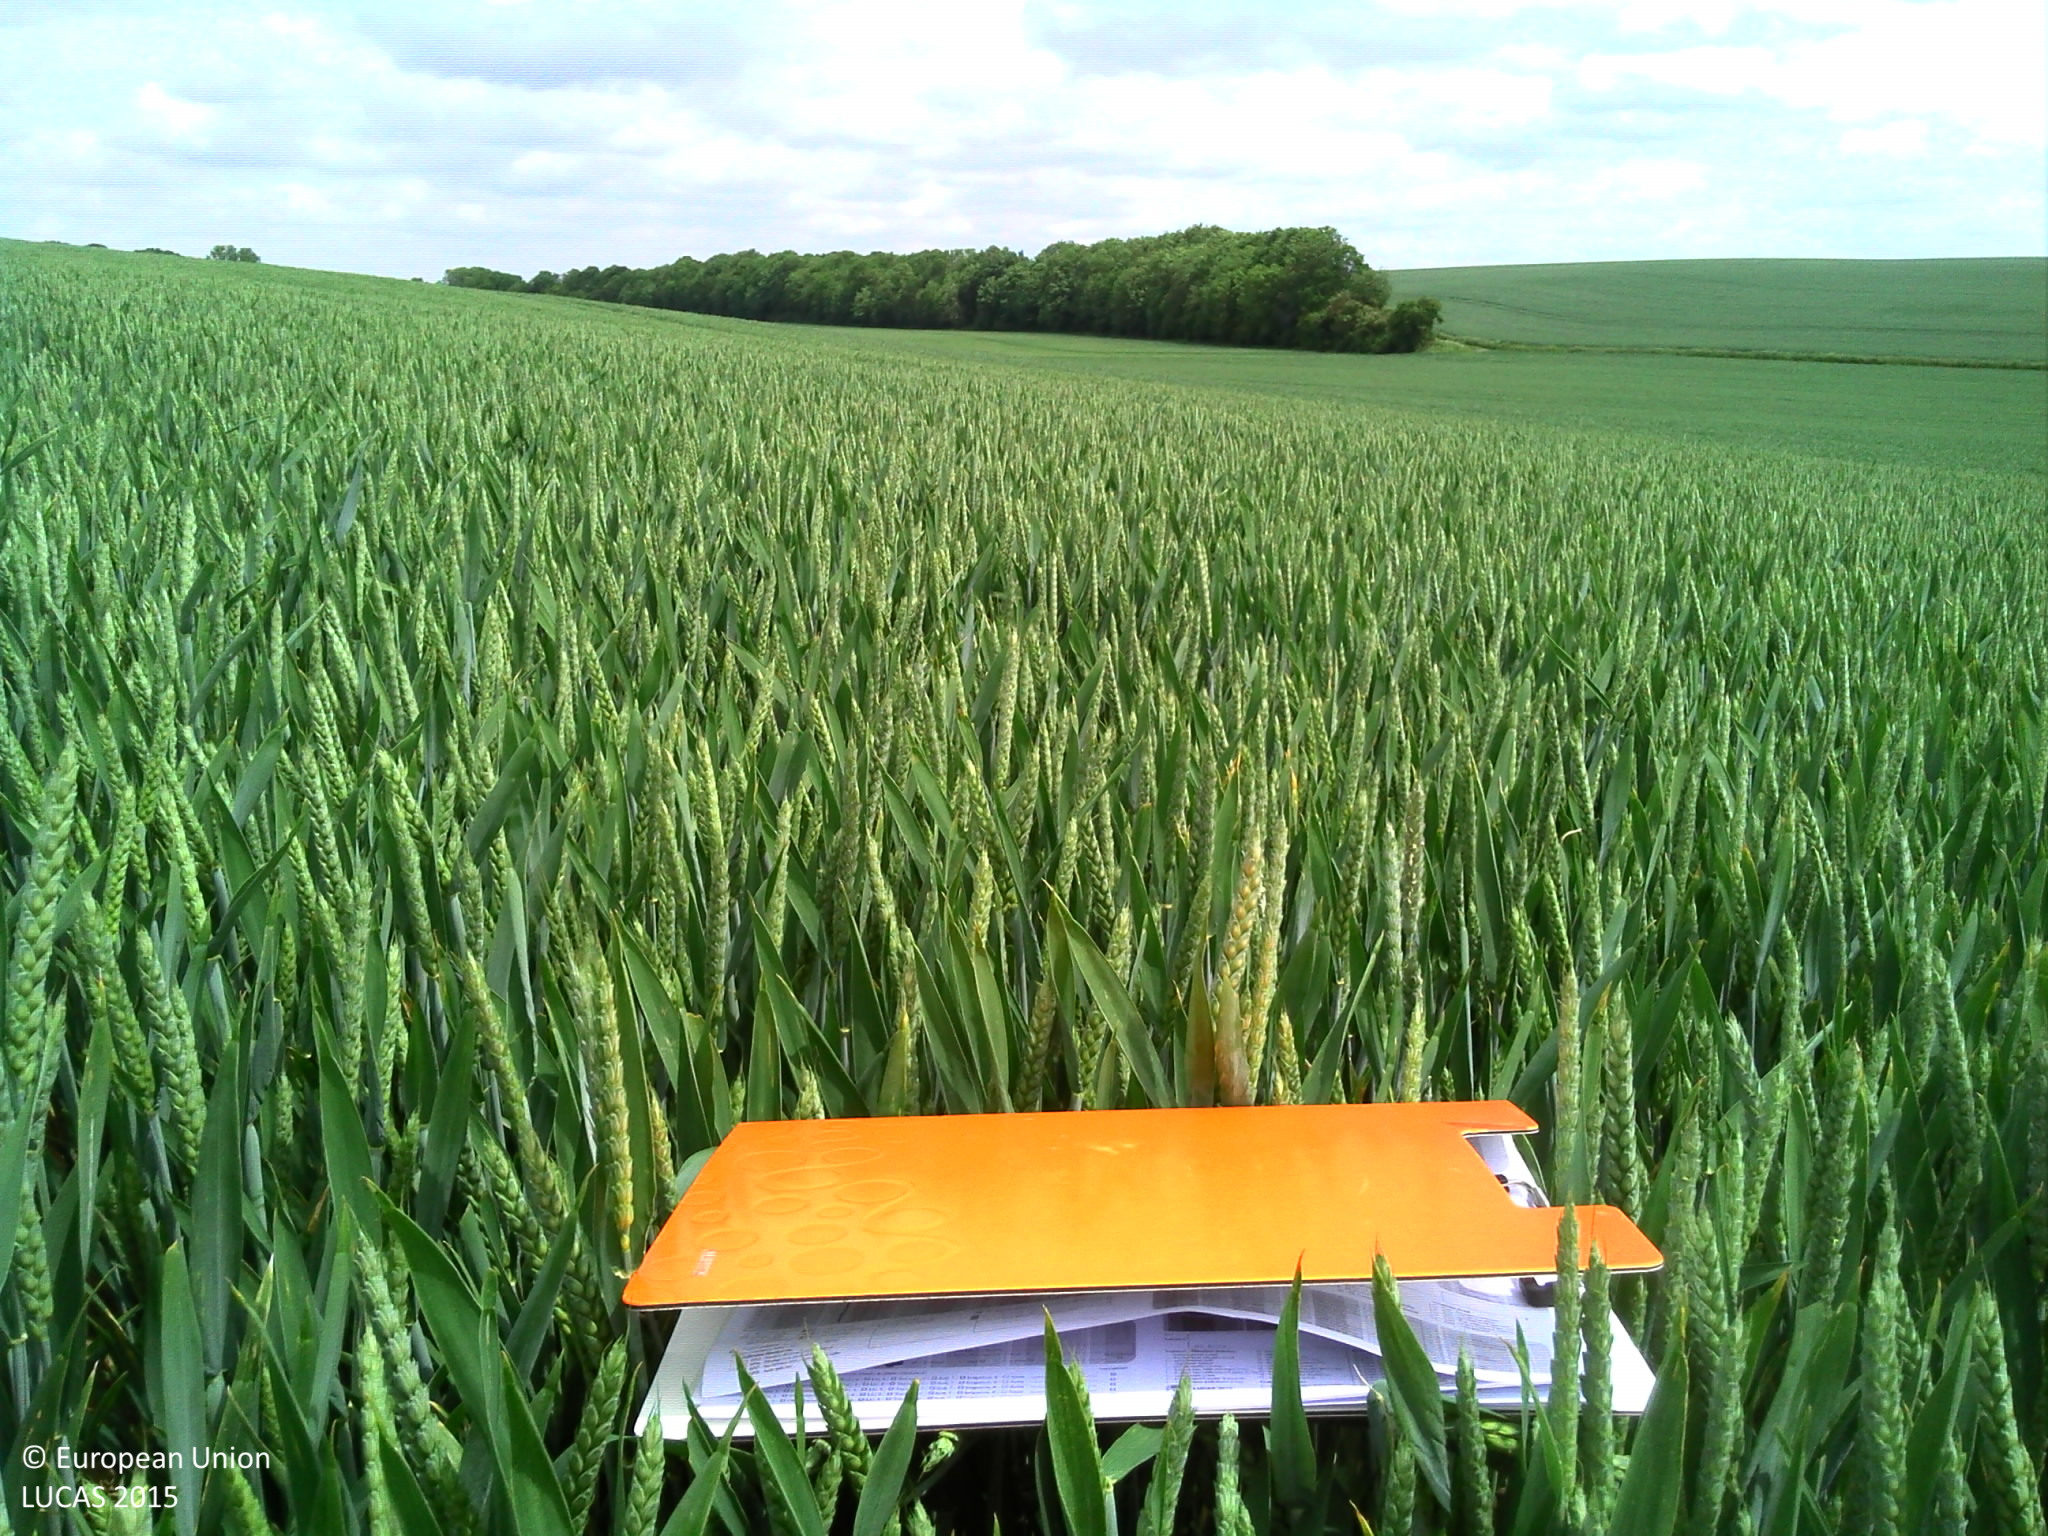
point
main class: Cropland
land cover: Common wheat
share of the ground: > 75 %
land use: Agriculture (excluding fallow land and kitchen gardens)
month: May
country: FR
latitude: 49.8005
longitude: 3.1973
